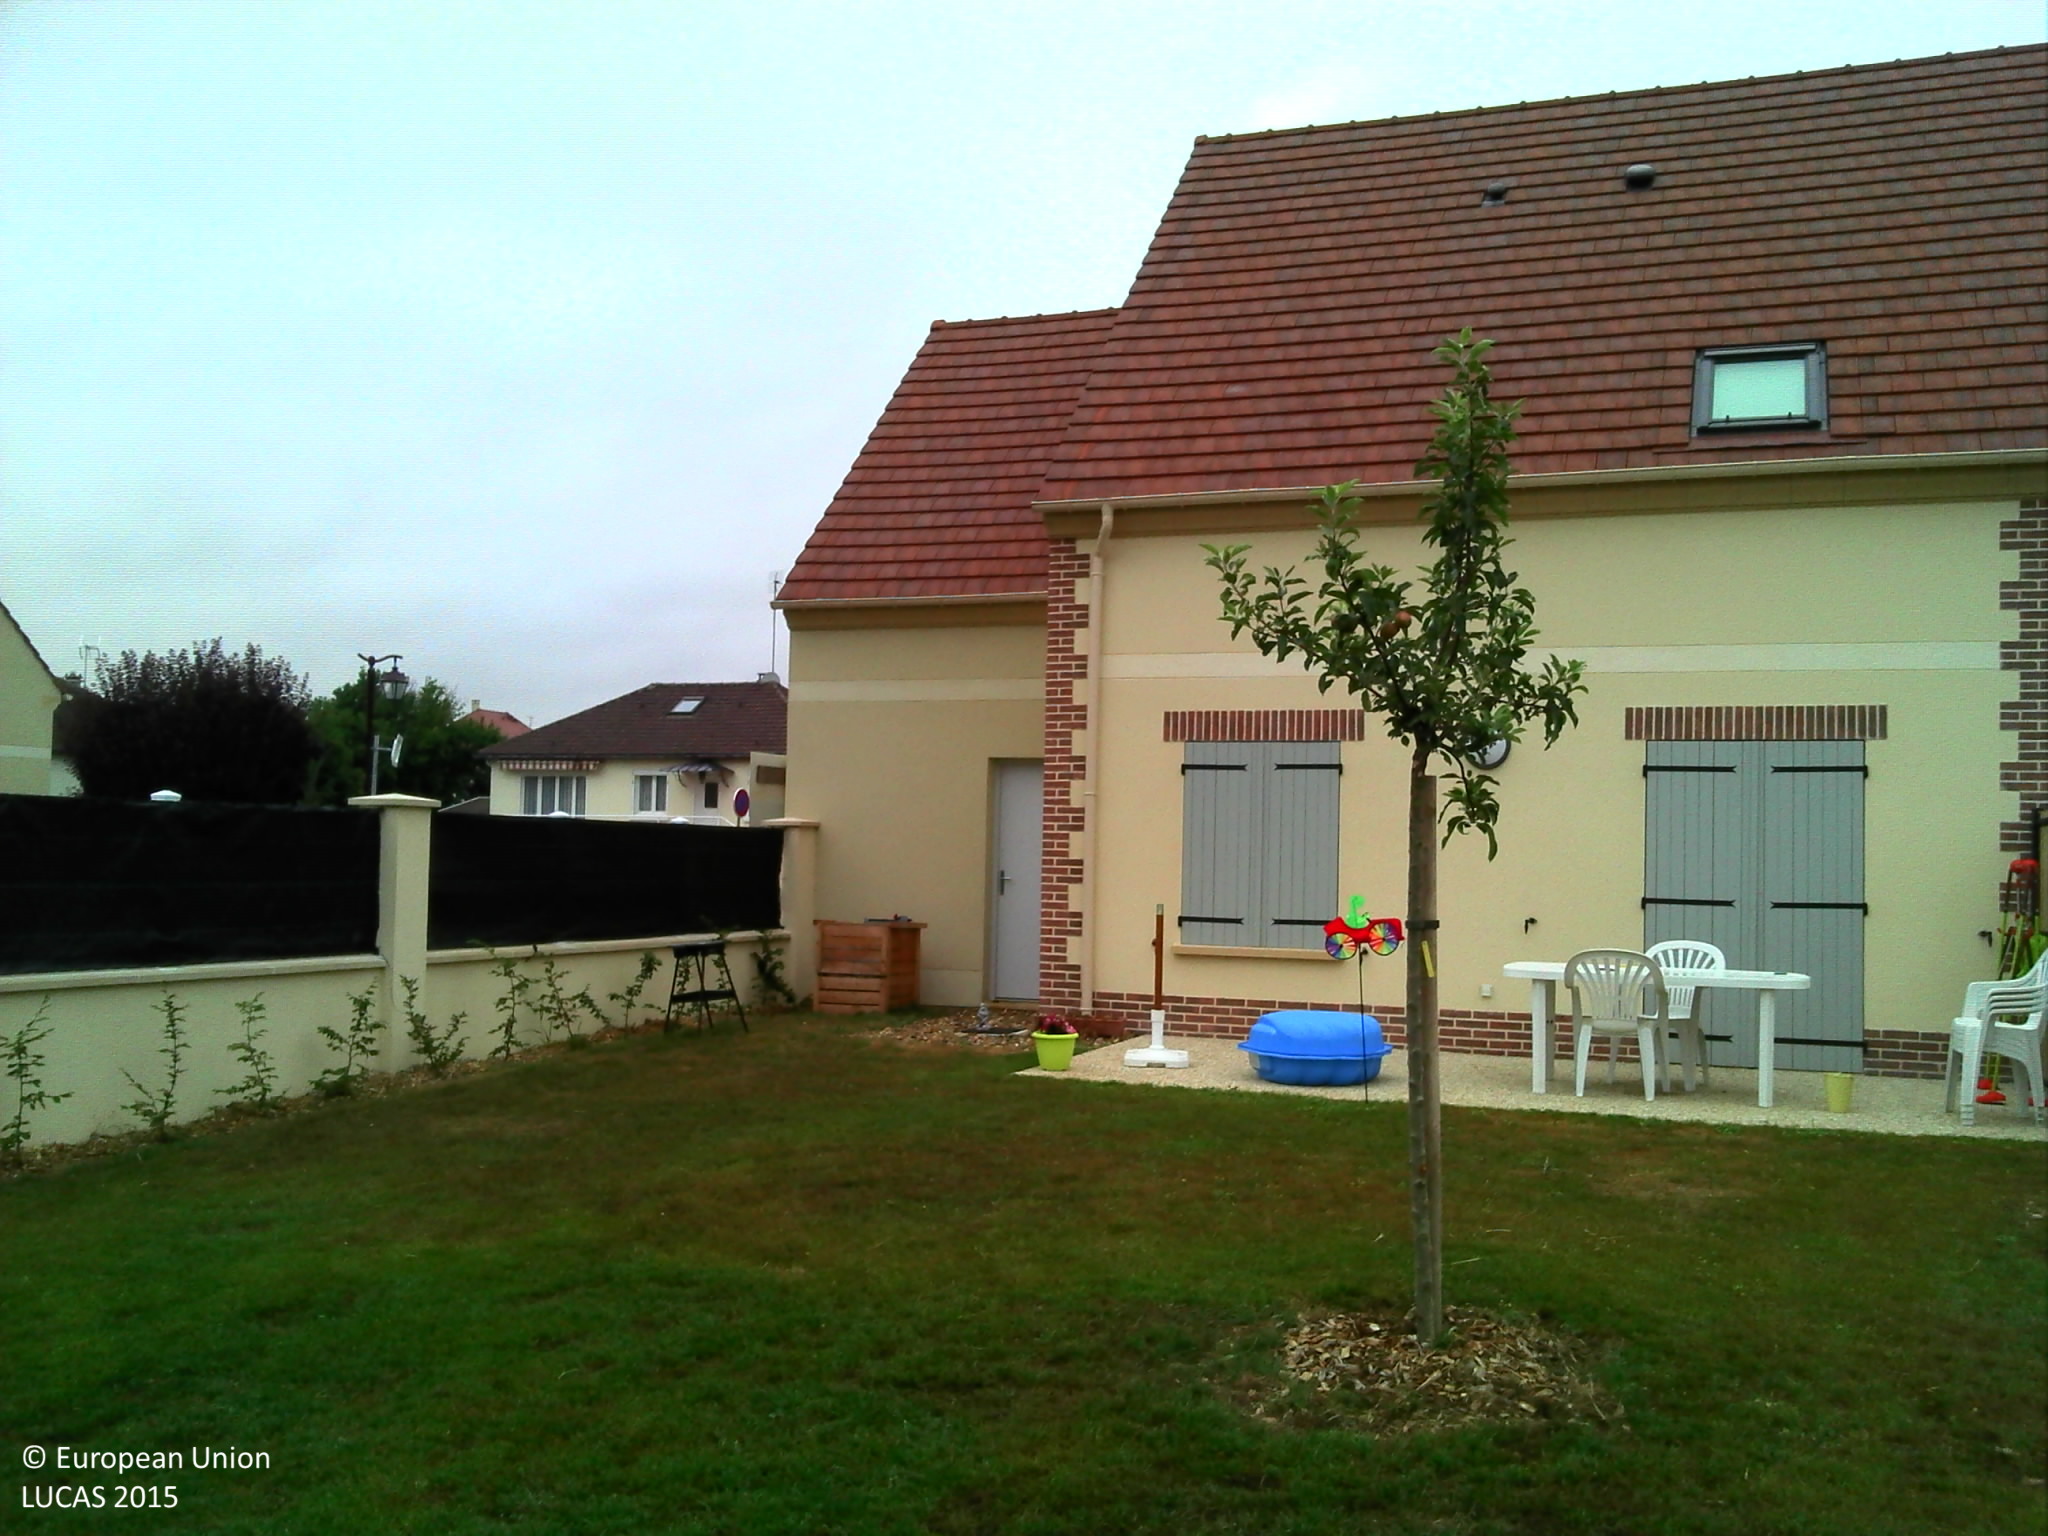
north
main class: Grassland
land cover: Grassland with sparse tree/shrub cover
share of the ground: > 75 %
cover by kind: herbaceous plants 95 %, broadleaved forest trees 5 %
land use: Residential
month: July
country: FR
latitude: 49.3901
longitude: 2.4241
